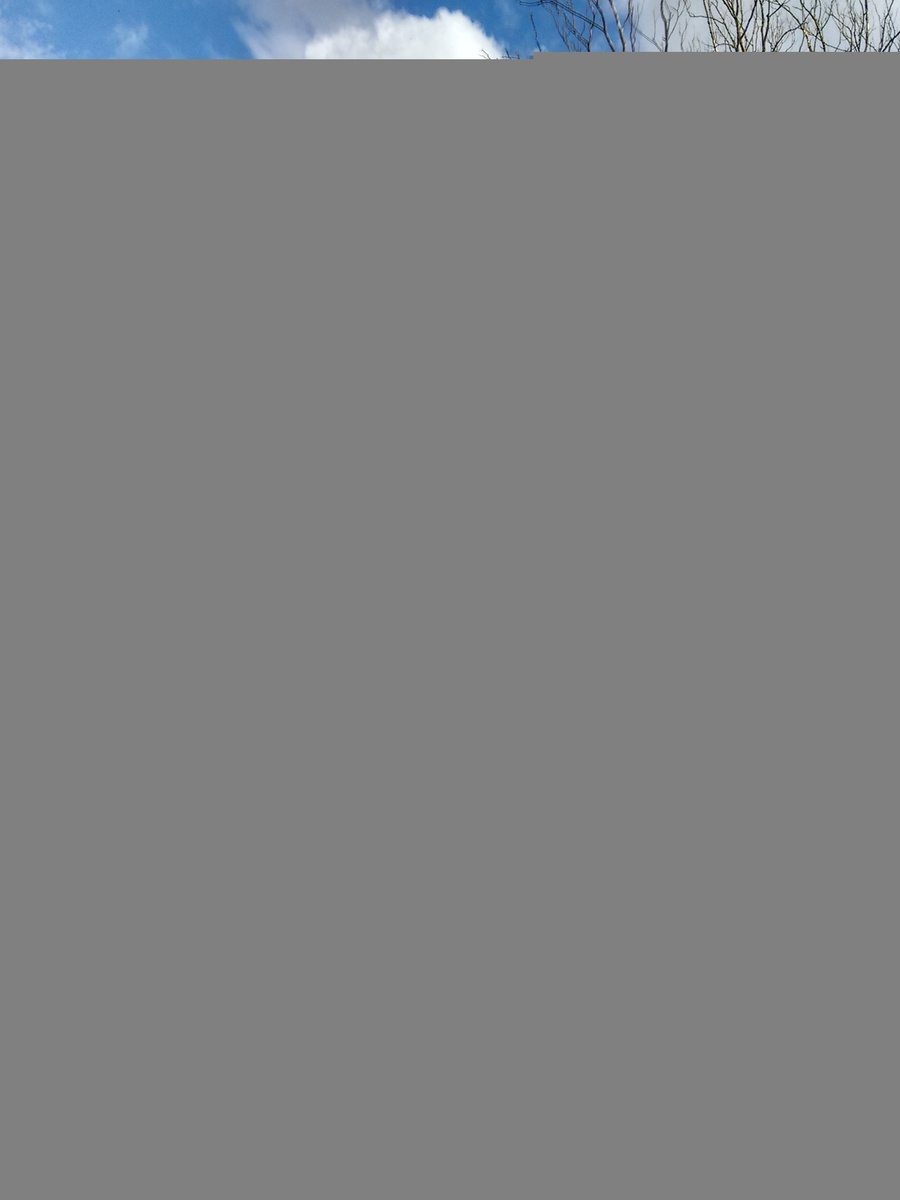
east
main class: Woodland
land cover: Broadleaved woodland
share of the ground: > 75 %
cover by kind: broadleaved forest trees 90 %, shrubs 10 %
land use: Agriculture (excluding fallow land and kitchen gardens)
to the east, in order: Broadleaved woodland; Grassland without tree/shrub cover; Lines of trees; Rivers and streams; Grassland without tree/shrub cover; Fences; Managed hedges; Electric lines; Grass margins; Paved roads, cycling and walking lanes; Grass margins; Abandoned hedges; Fences; Grassland without tree/shrub cover; Fences; Abandoned hedges; Tracks; Abandoned hedges; Fences; Grassland without tree/shrub cover
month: September
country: GB
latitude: 53.1069
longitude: -3.0868
